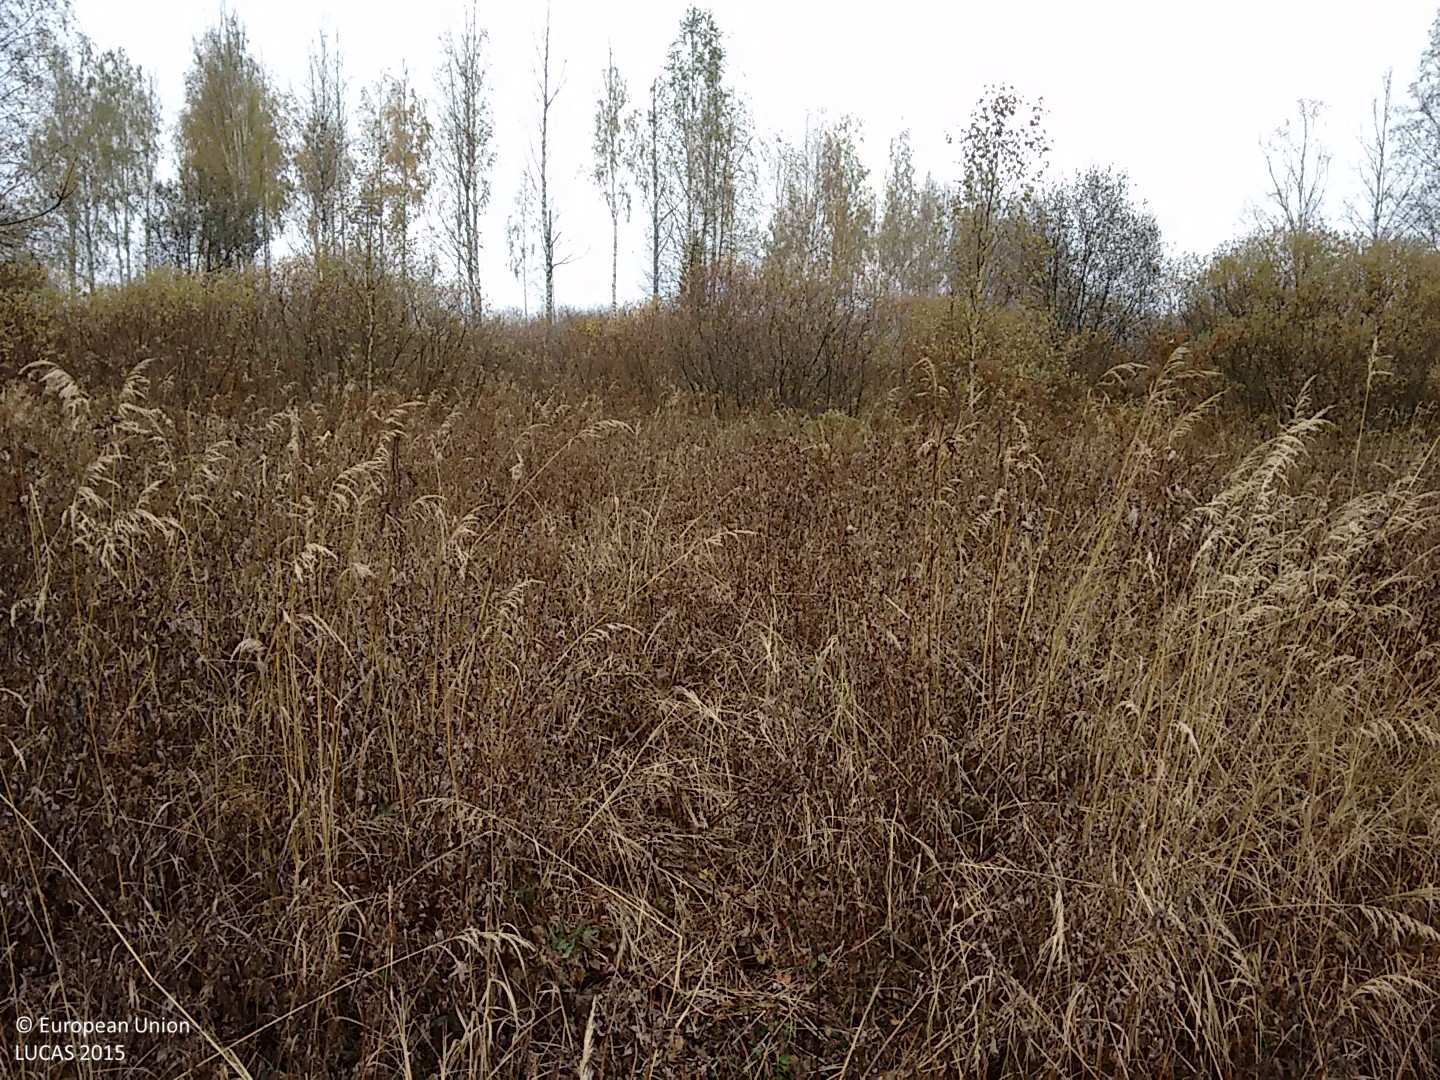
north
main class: Shrubland
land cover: Shrubland with sparse tree cover
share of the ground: 25 - 50 %
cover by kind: shrubs 45 %, herbaceous plants 45 %, broadleaved forest trees 5 %, lichens and mosses 5 %
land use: Forestry
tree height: < 5 m
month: October
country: FI
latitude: 62.6702
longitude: 26.3562
